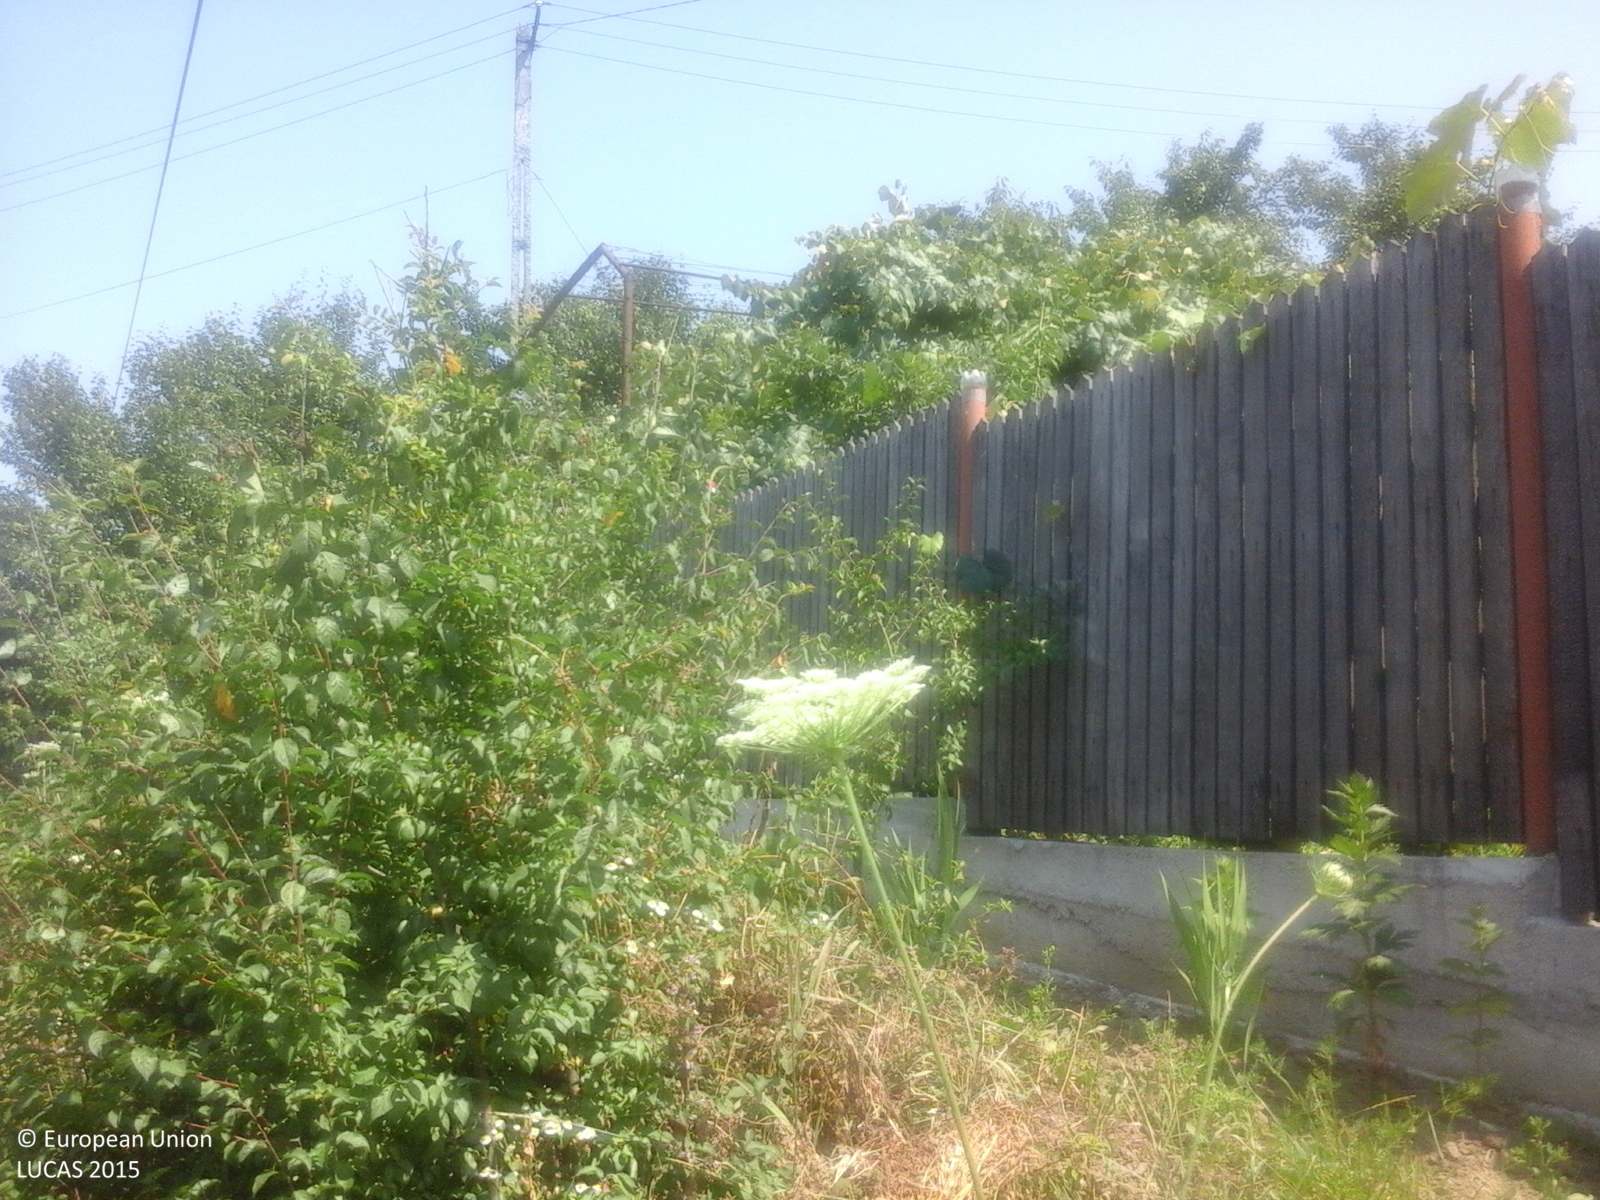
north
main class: Grassland
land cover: Grassland without tree/shrub cover
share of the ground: > 75 %
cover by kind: herbaceous plants 100 %
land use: Agriculture (excluding fallow land and kitchen gardens)
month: July
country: RO
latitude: 44.9033
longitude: 24.7321
